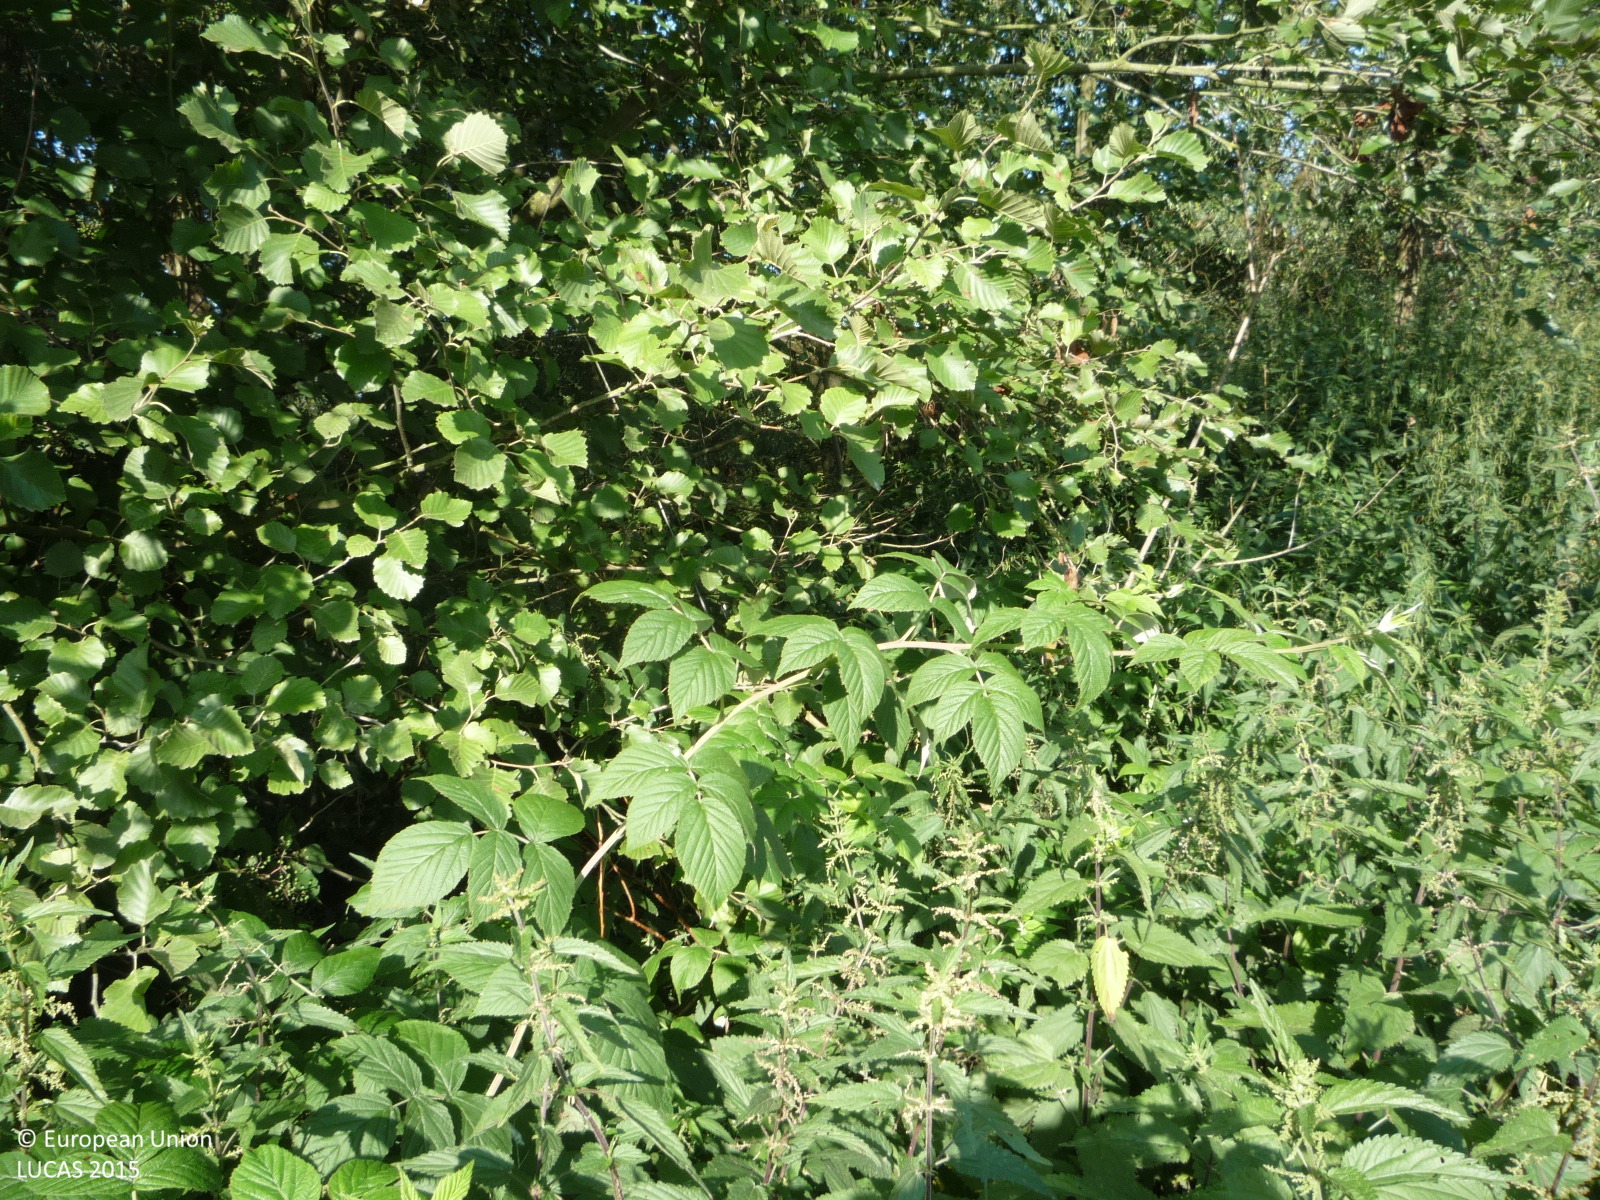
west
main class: Grassland
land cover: Grassland without tree/shrub cover
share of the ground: > 75 %
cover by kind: herbaceous plants 100 %
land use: Agriculture (excluding fallow land and kitchen gardens)
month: July
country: CZ
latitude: 50.4261
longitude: 15.1975
